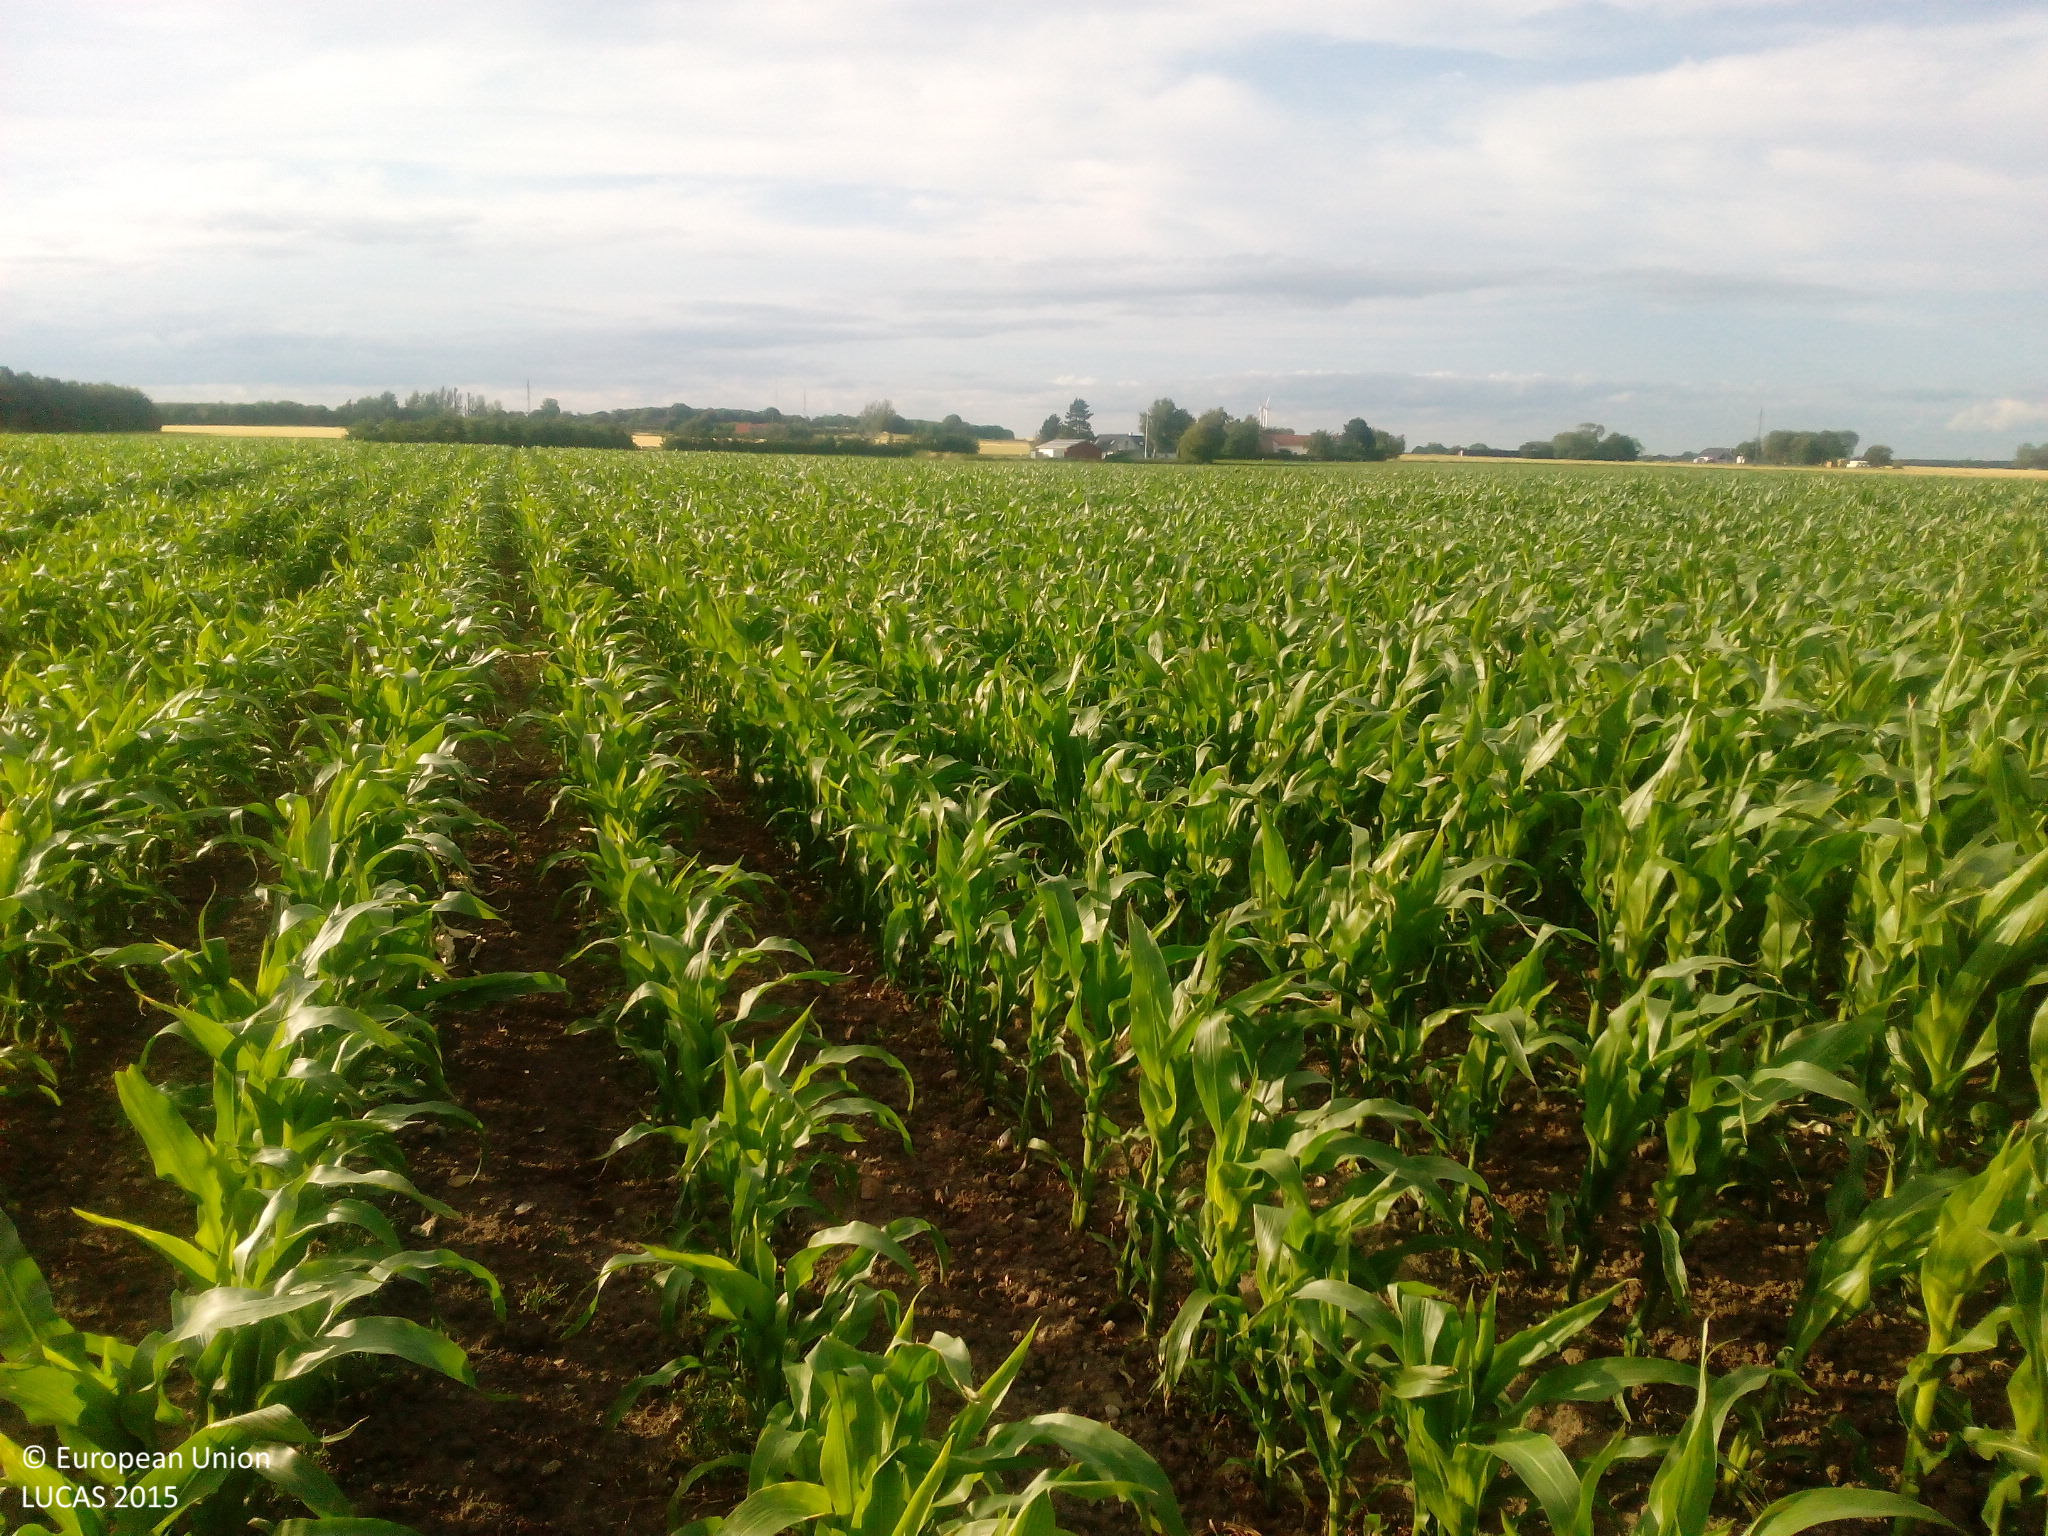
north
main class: Cropland
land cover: Maize
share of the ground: > 75 %
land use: Agriculture (excluding fallow land and kitchen gardens)
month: July
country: DK
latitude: 55.3728
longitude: 11.2455
